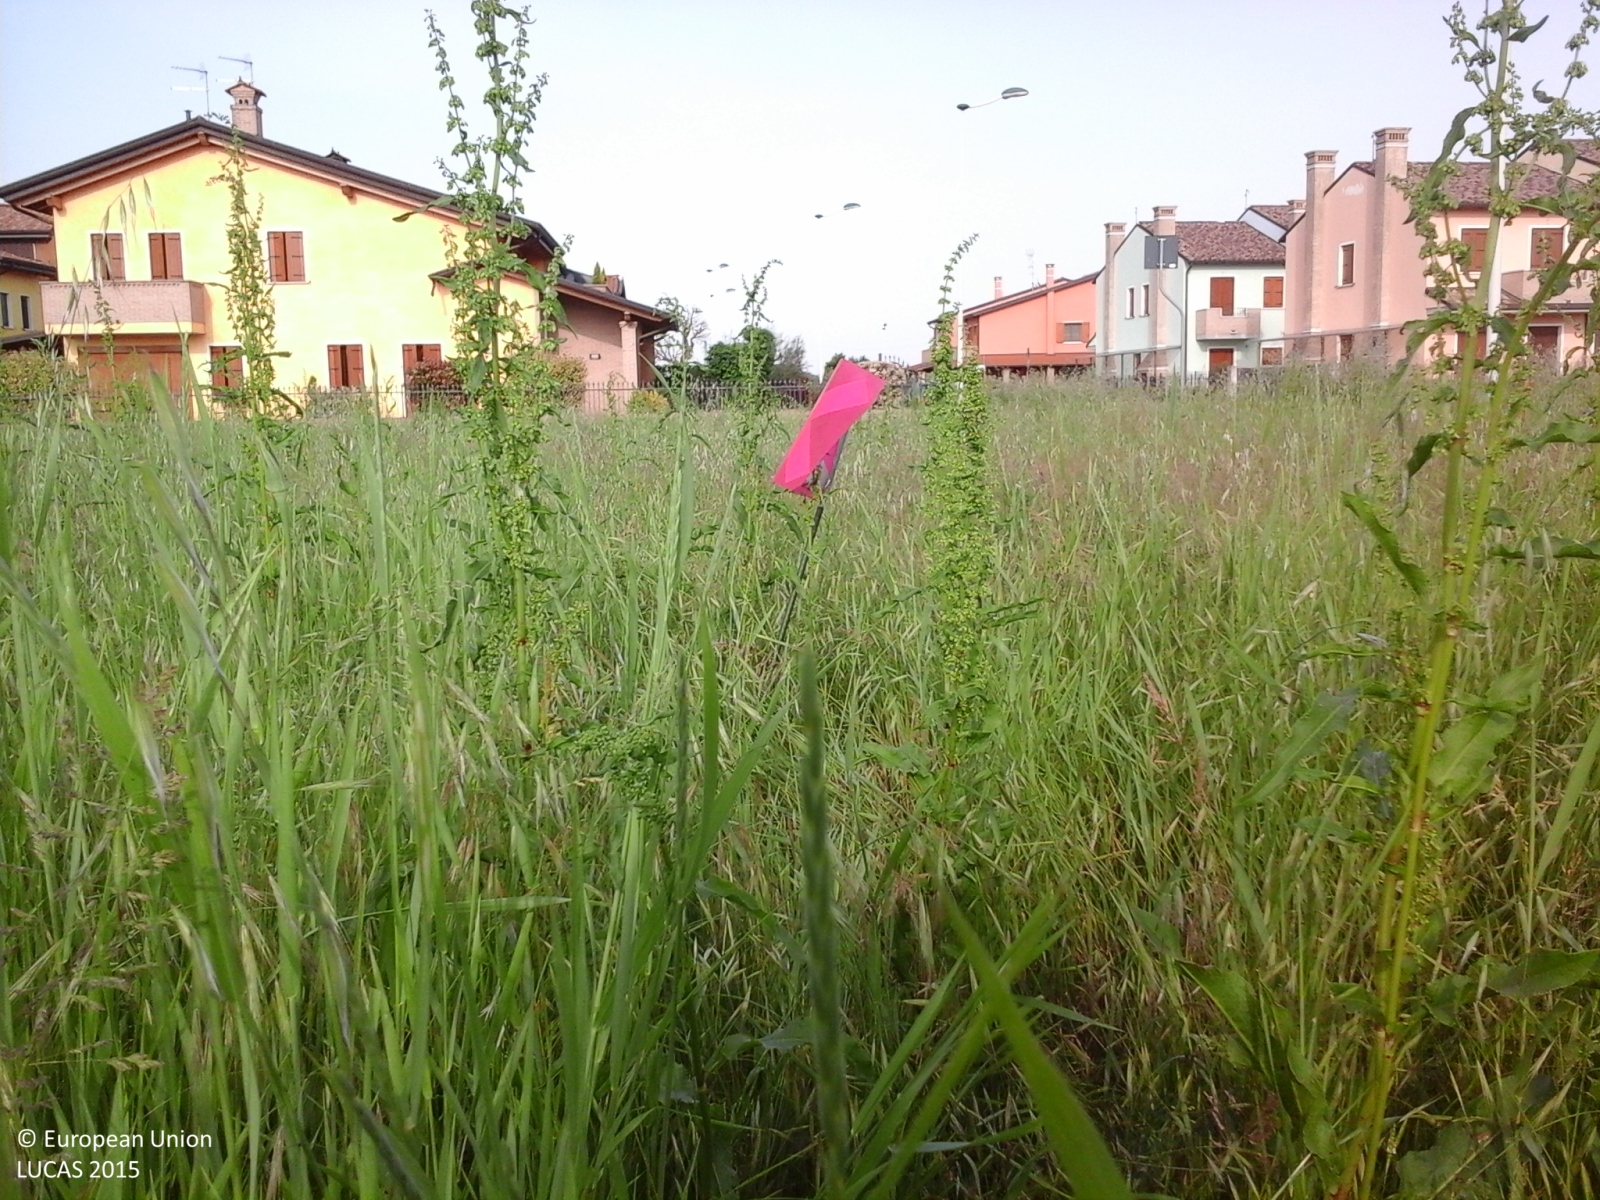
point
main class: Grassland
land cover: Spontaneously vegetated surfaces
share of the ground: > 75 %
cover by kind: herbaceous plants 100 %
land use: Abandoned areas
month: May
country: IT
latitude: 45.1840
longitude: 11.7150
